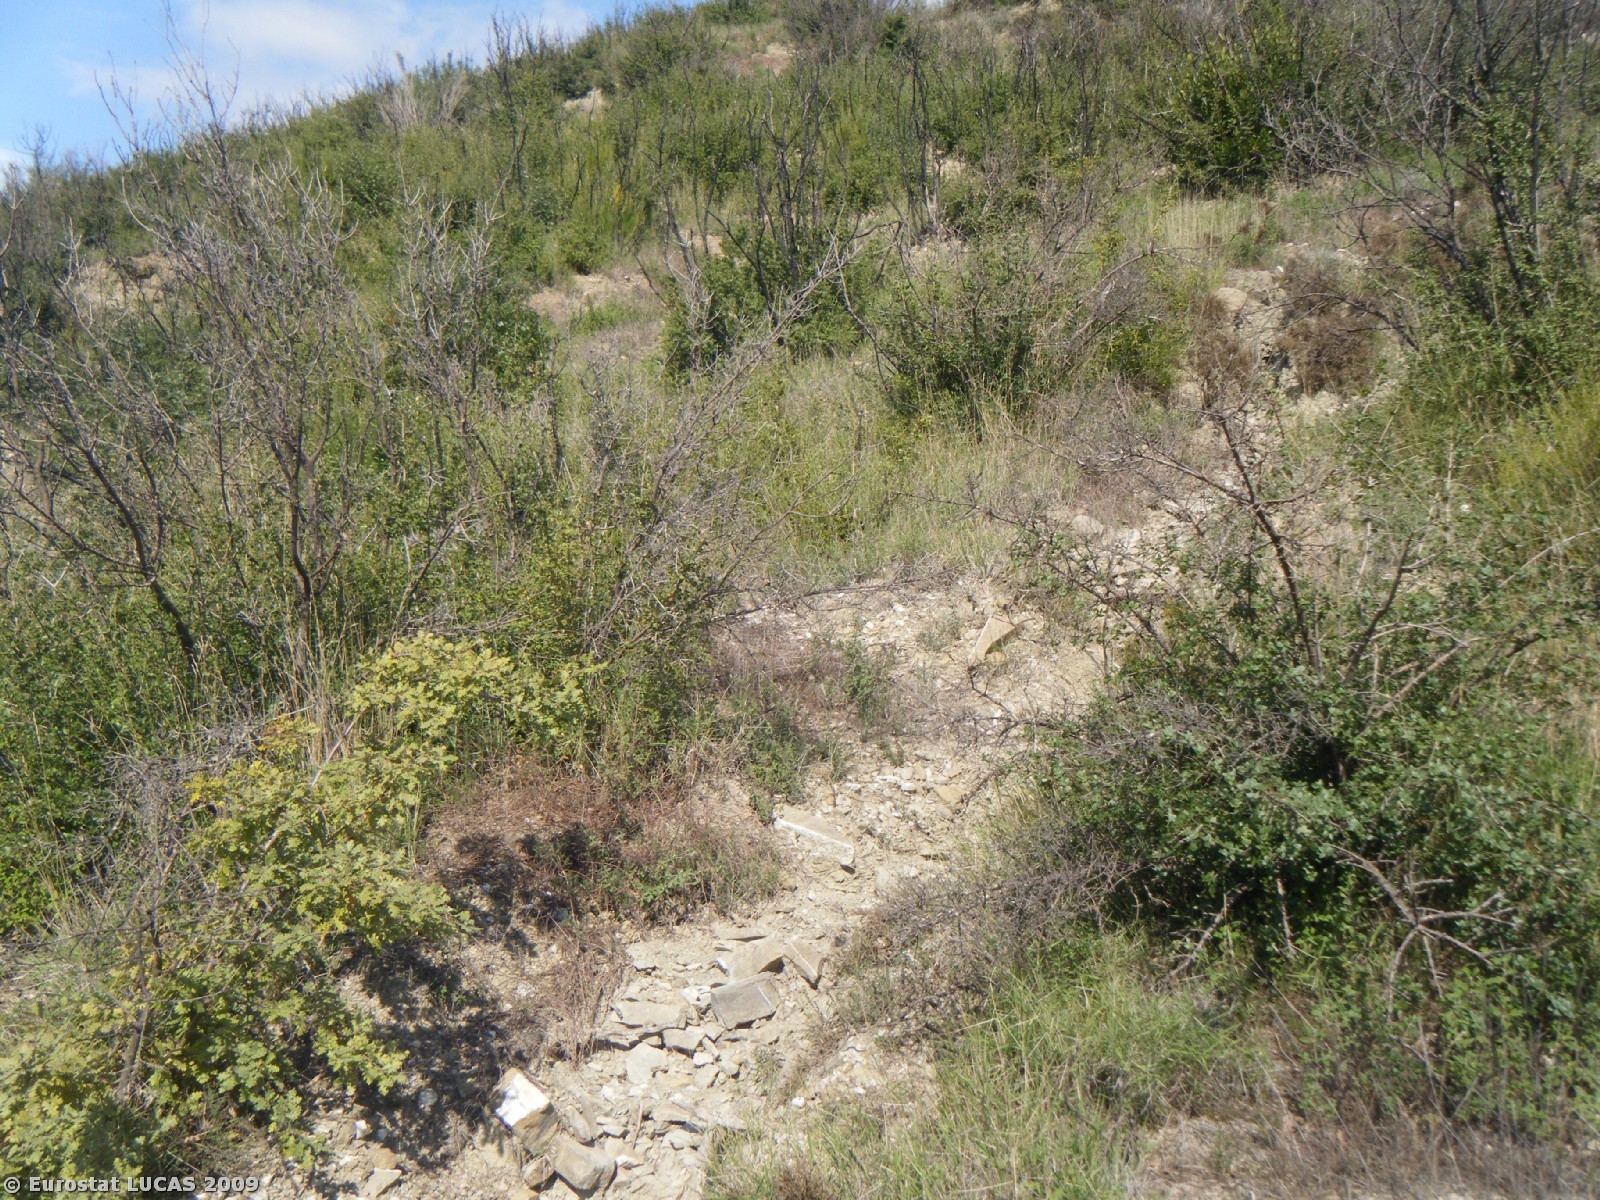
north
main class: Shrubland
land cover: Shrubland without tree cover
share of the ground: > 75 %
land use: Unused
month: October
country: GR
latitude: 37.2383
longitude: 22.1646
